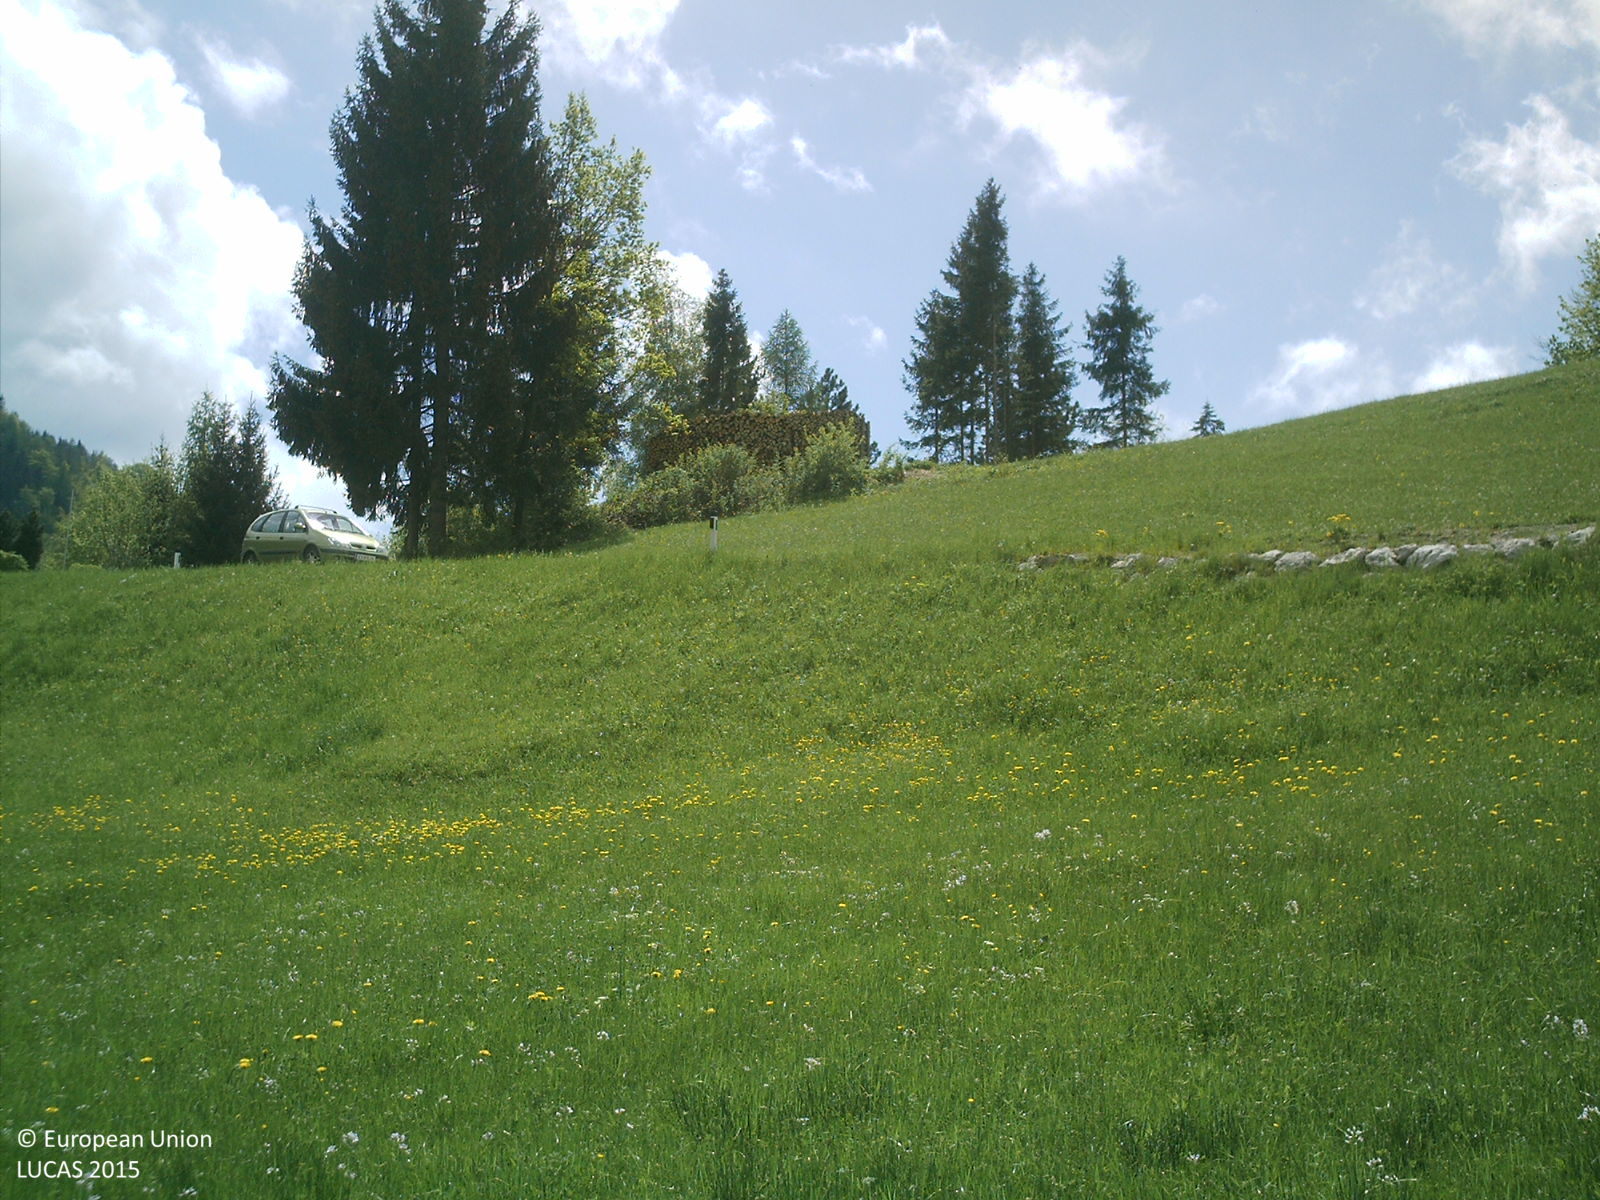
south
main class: Grassland
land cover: Grassland without tree/shrub cover
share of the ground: > 75 %
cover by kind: herbaceous plants 100 %
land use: Agriculture (excluding fallow land and kitchen gardens)
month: May
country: AT
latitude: 47.8928
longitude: 14.1591
